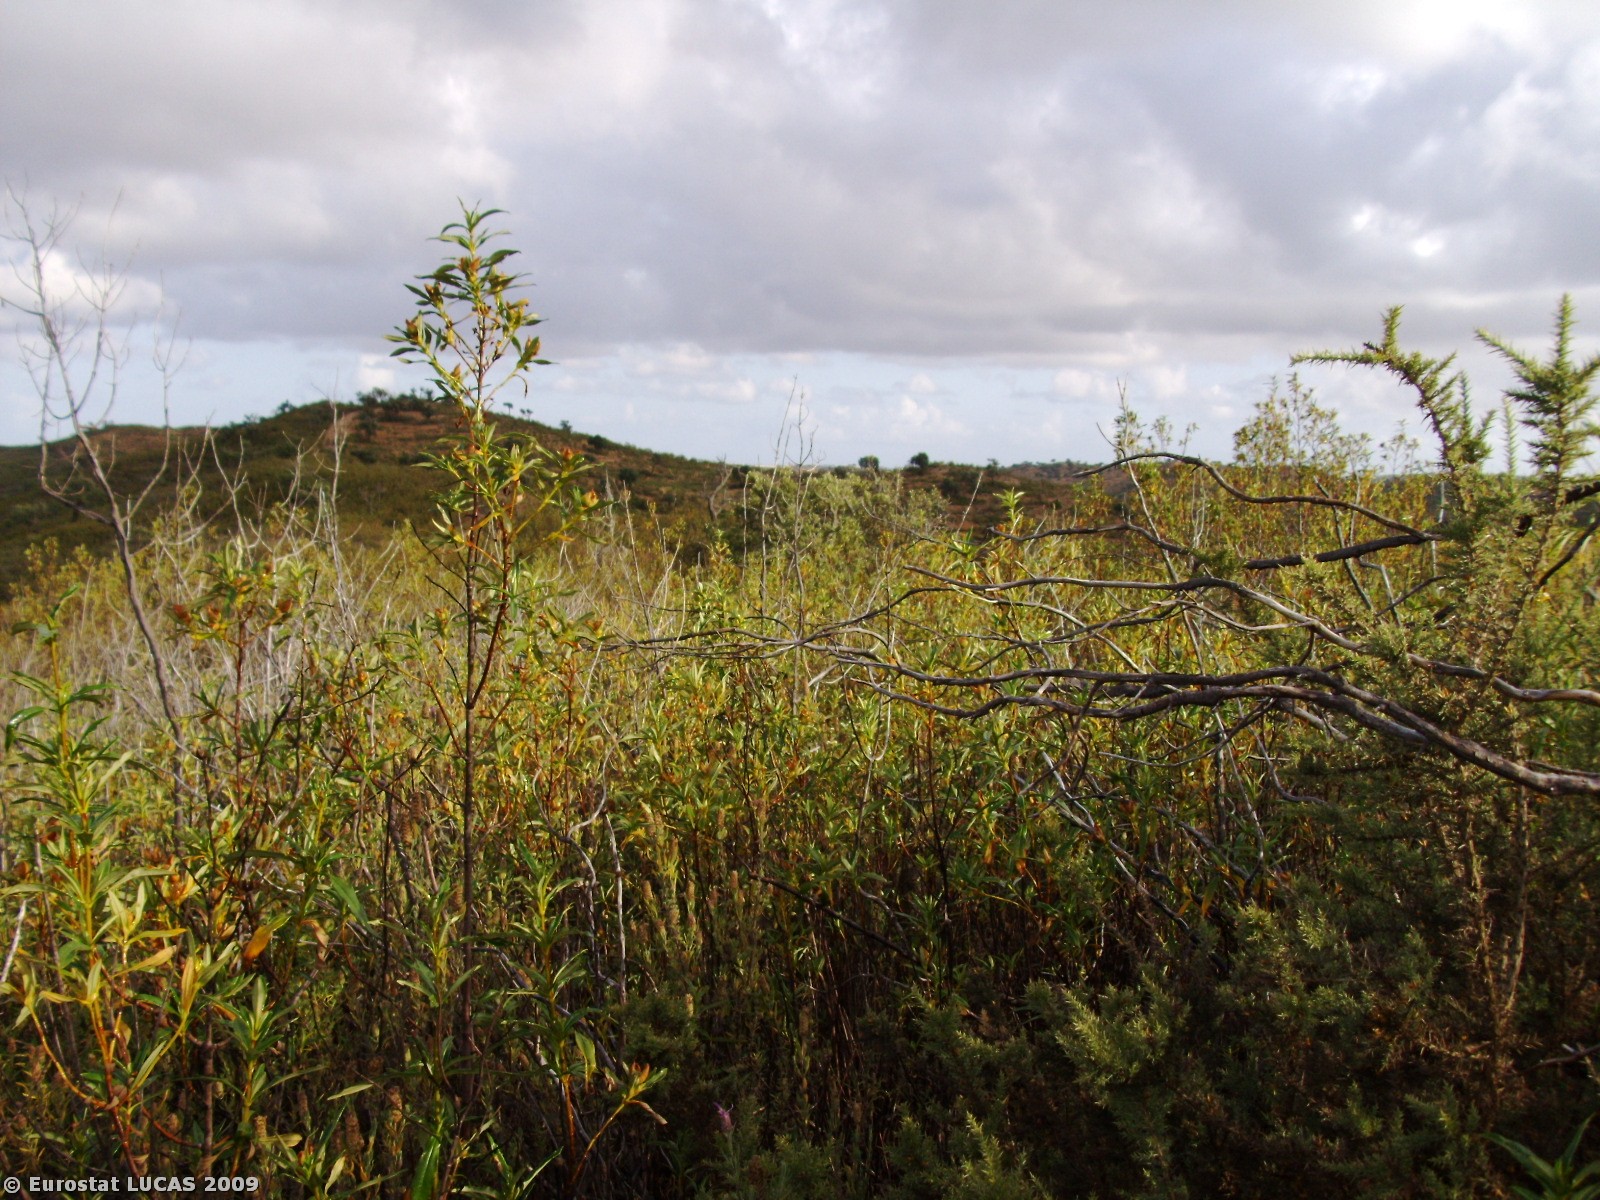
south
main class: Shrubland
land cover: Shrubland without tree cover
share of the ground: > 75 %
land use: Unused
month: June
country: PT
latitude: 37.2182
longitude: -8.7509
